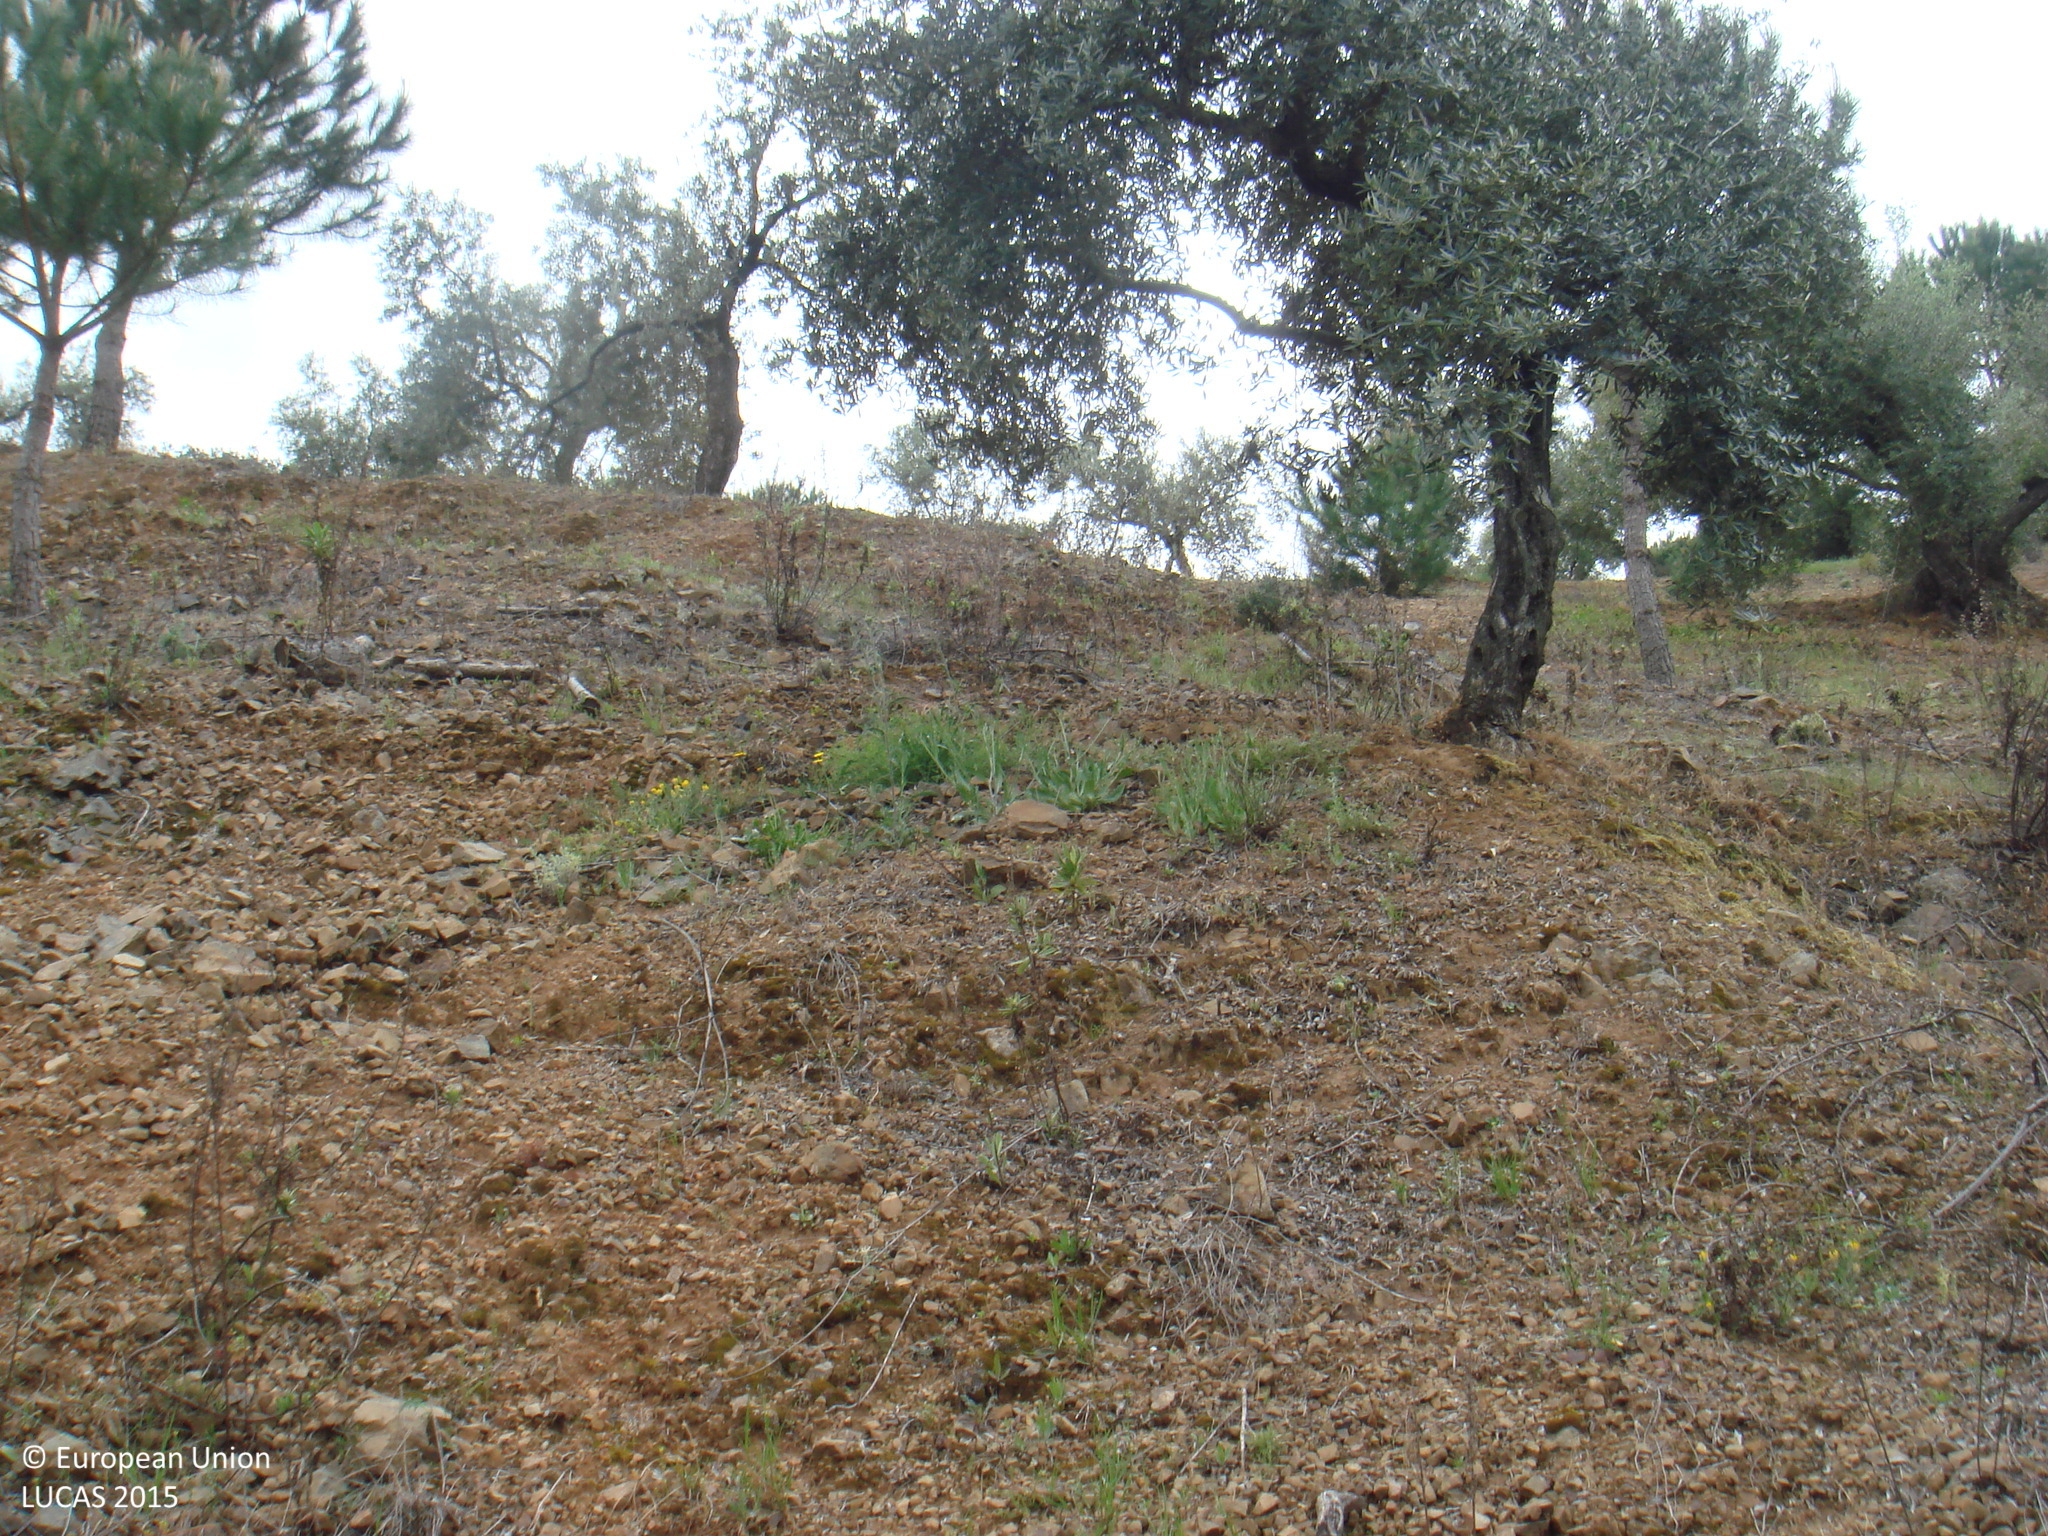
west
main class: Cropland
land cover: Olive groves
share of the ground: 10 - 25 %
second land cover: Spontaneously vegetated surfaces
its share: 50 - 75 %
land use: Agriculture (excluding fallow land and kitchen gardens)
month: April
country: ES
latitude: 38.0580
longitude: -5.0075
